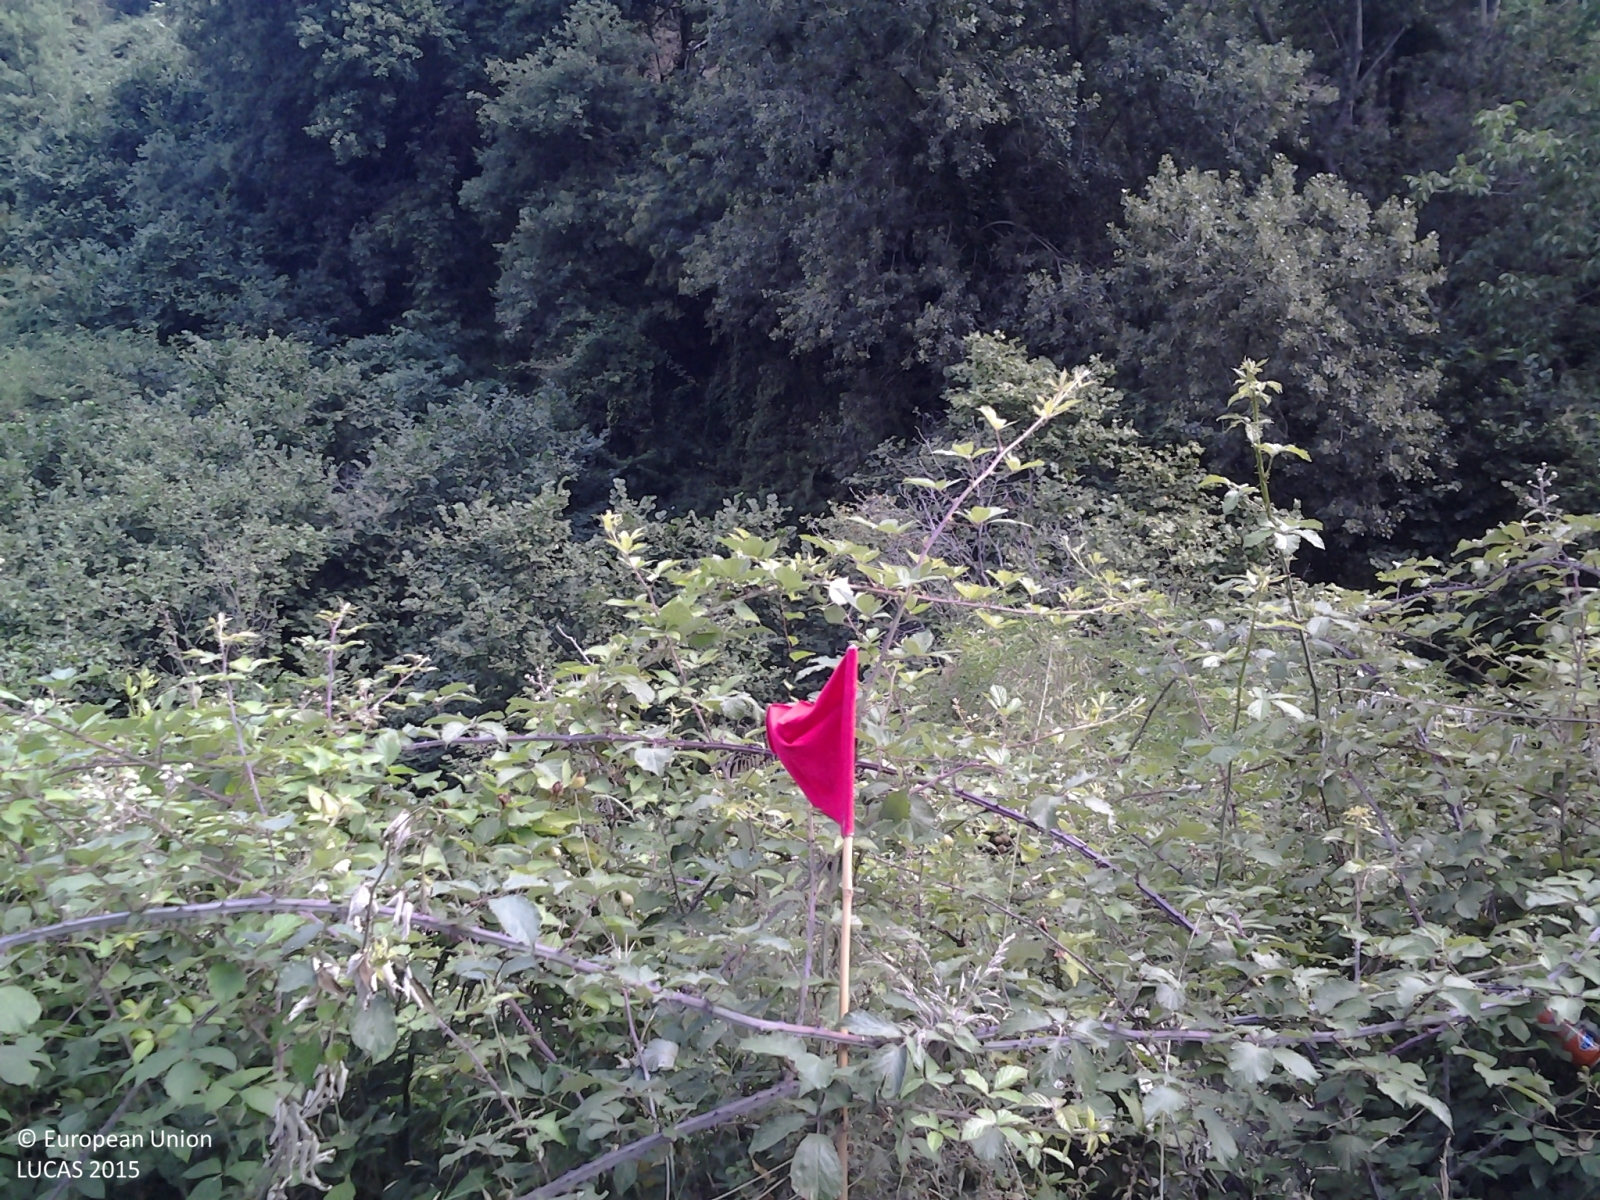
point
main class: Shrubland
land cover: Shrubland with sparse tree cover
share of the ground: > 75 %
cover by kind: shrubs 85 %, broadleaved forest trees 5 %, herbaceous plants 5 %
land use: Semi-natural and natural areas not in use
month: July
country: IT
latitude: 38.1298
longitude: 14.9075
